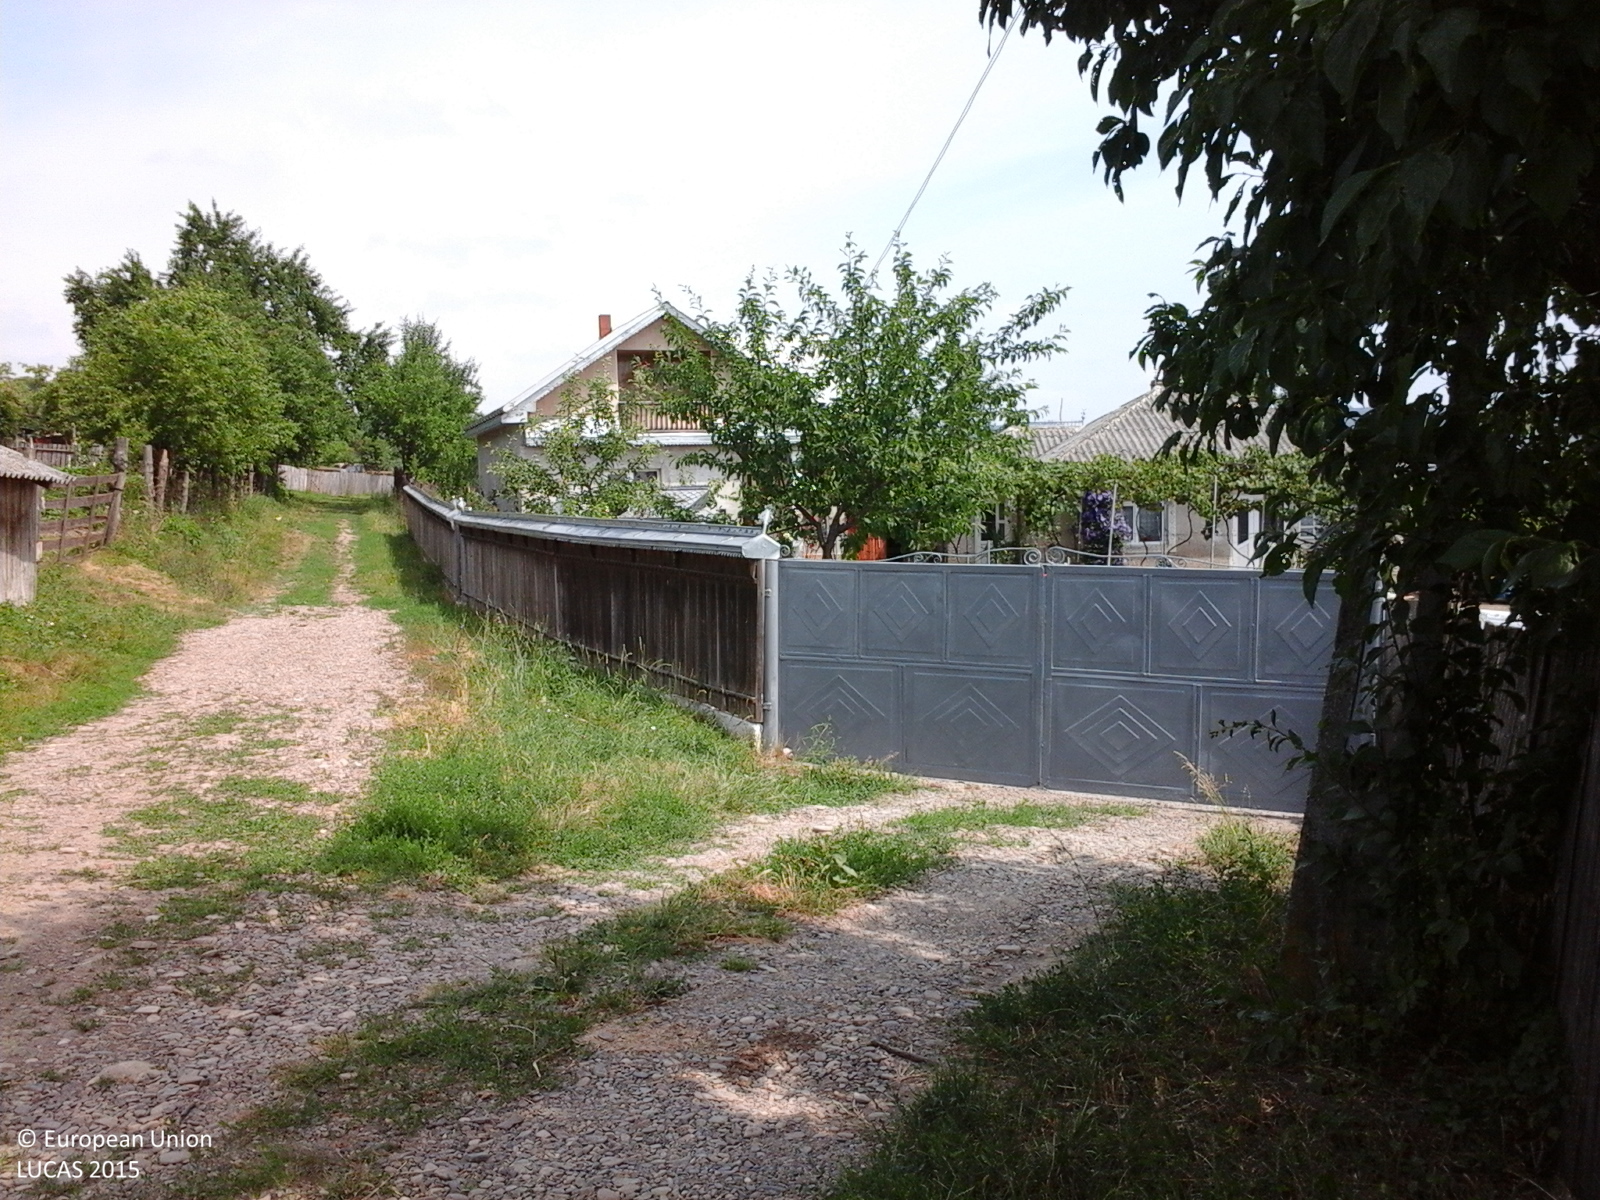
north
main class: Cropland
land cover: Other root crops
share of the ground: > 75 %
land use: Kitchen garden
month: June
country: RO
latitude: 47.3936
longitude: 26.7213
